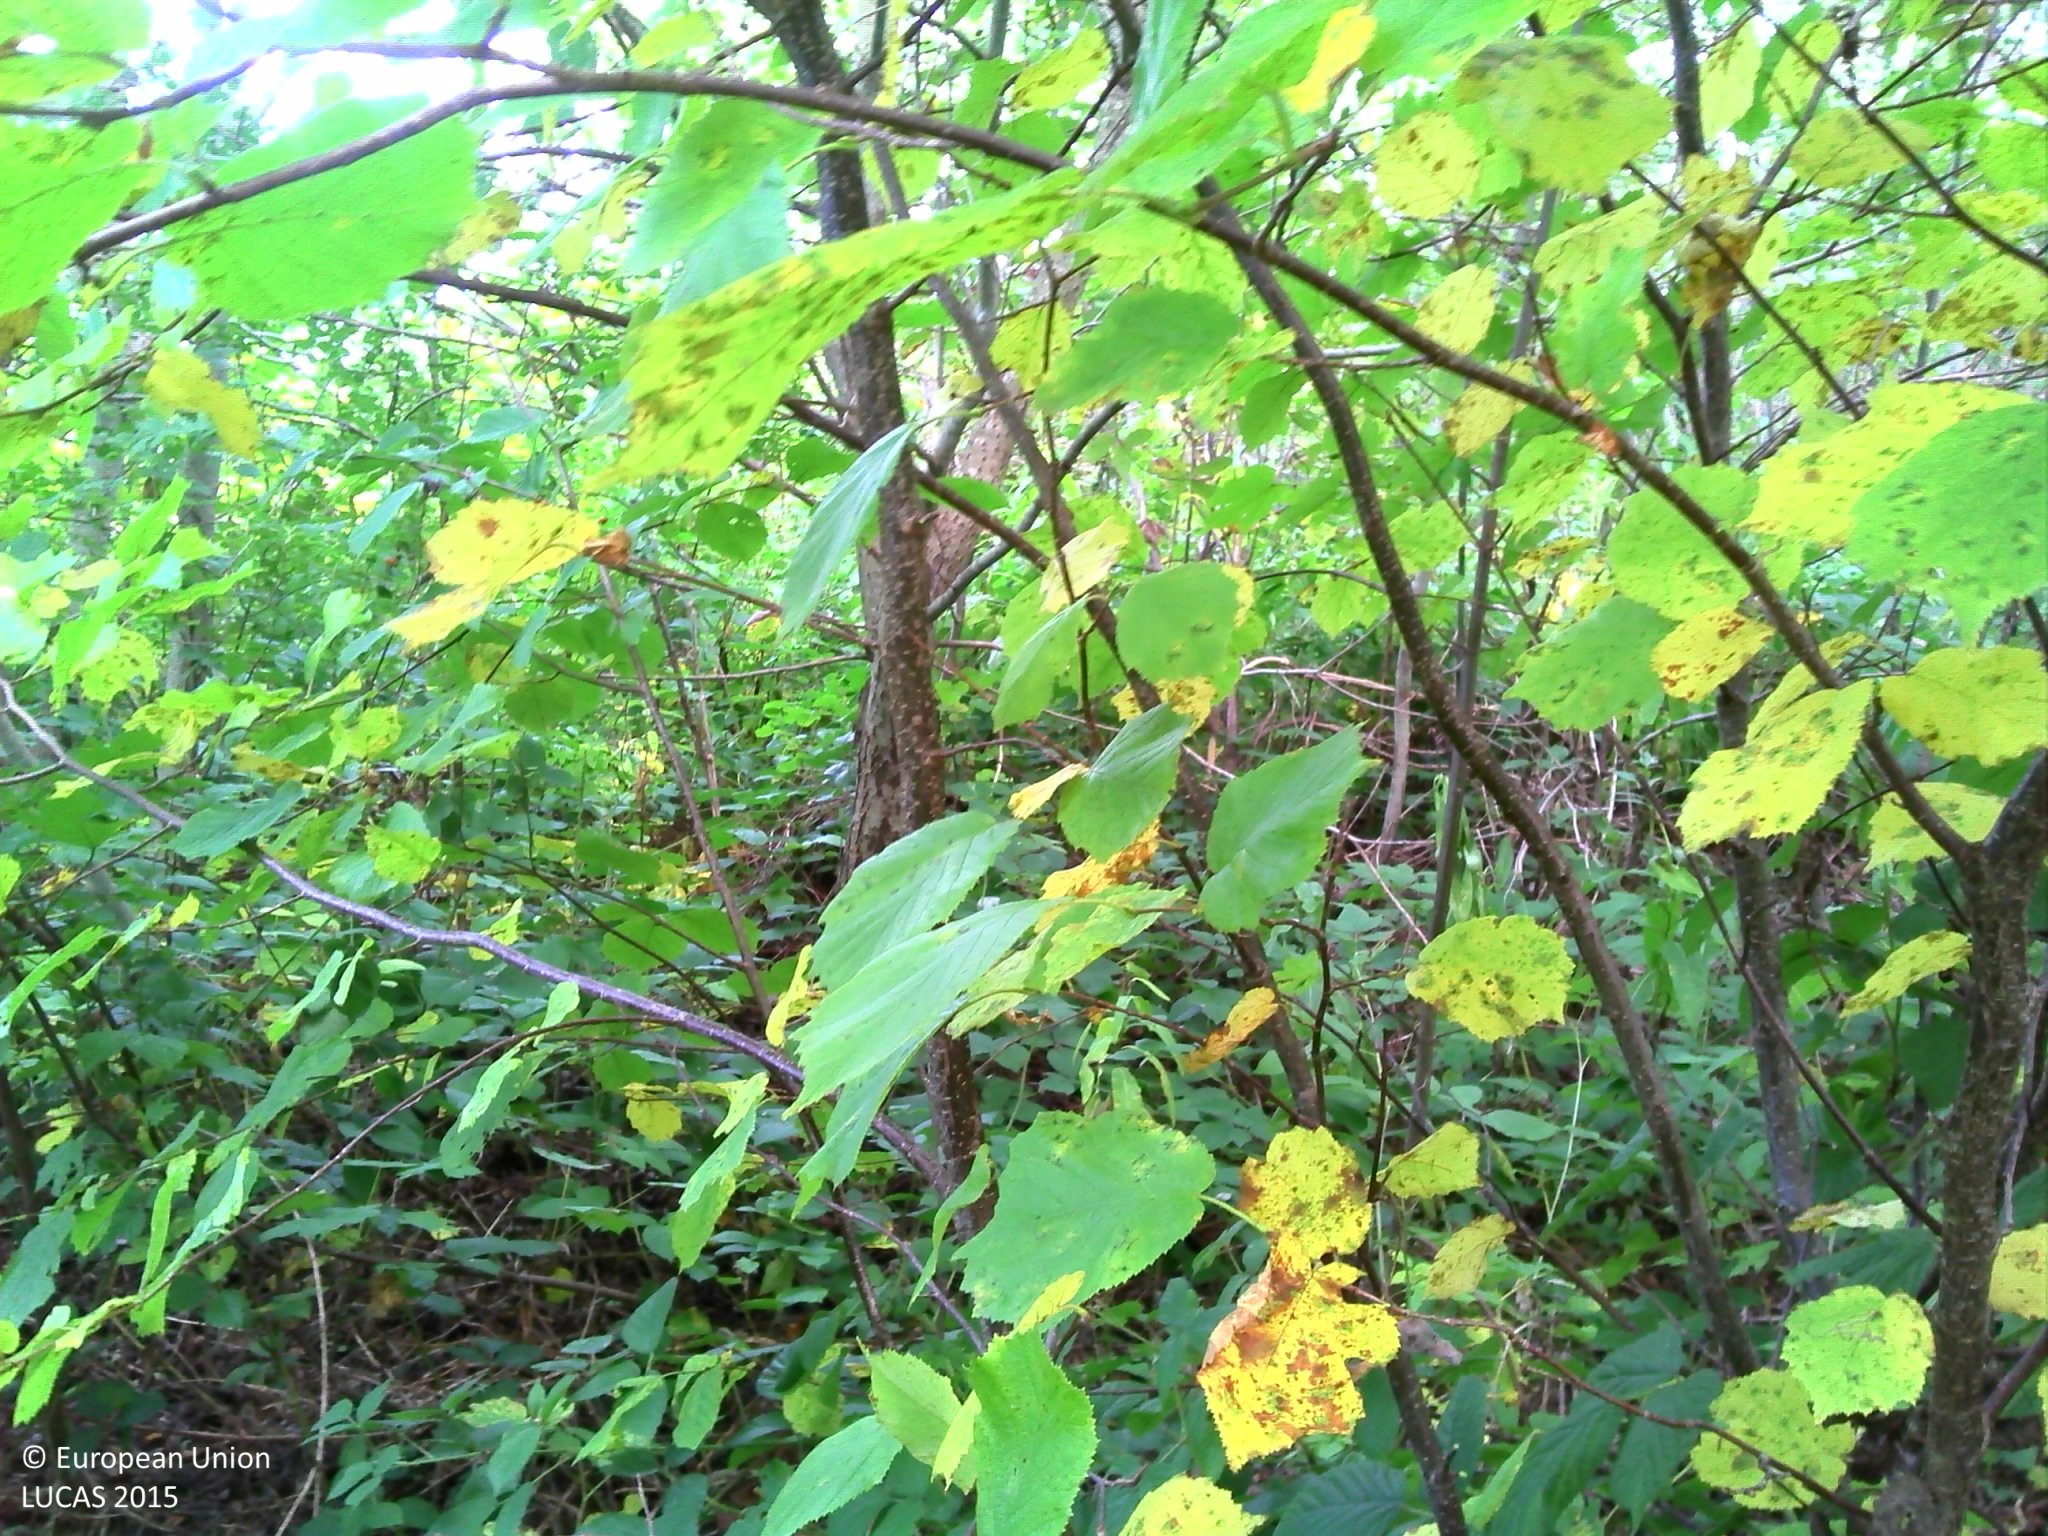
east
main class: Woodland
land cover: Broadleaved woodland
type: mesophytic deciduous forest
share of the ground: 50 - 75 %
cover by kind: broadleaved forest trees 75 %, shrubs 25 %
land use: Forestry
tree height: > 5 m
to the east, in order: Broadleaved woodland; Spruce dominated coniferous woodland
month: October
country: FR
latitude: 47.0283
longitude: 6.3574
